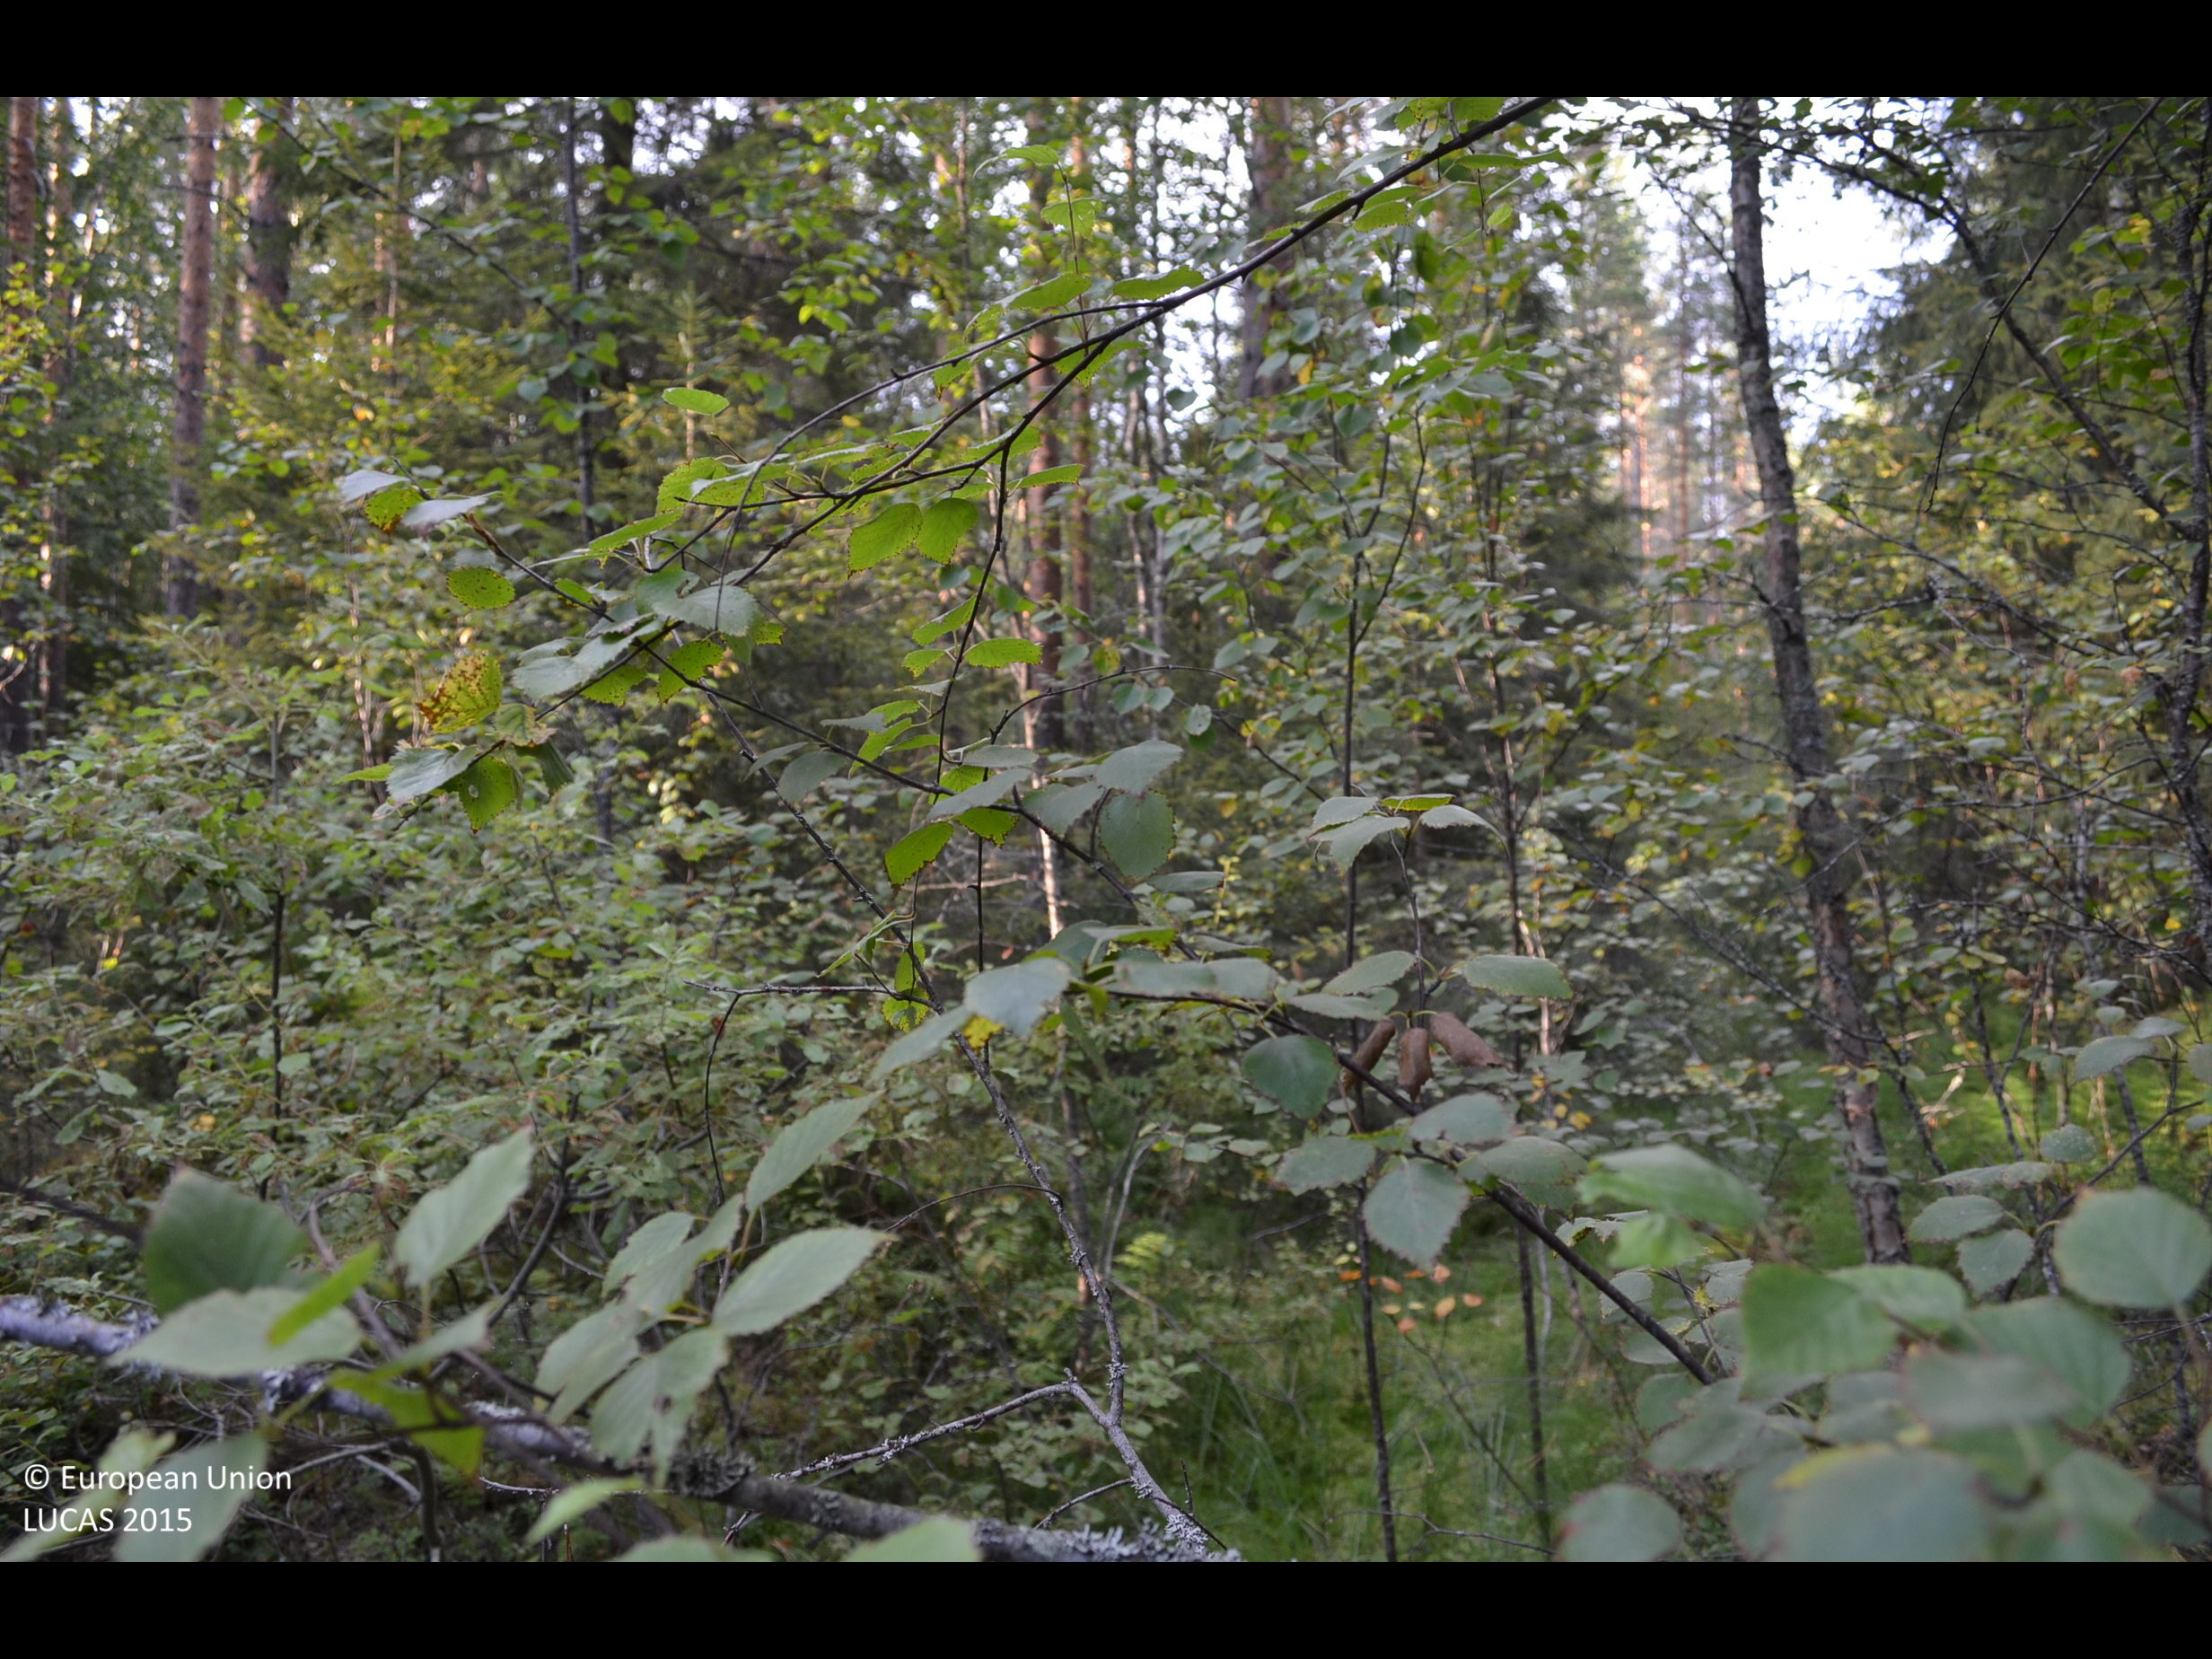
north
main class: Woodland
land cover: Pine dominated mixed woodland
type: boreal forest
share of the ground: > 75 %
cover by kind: coniferous forest trees 60 %, broadleaved forest trees 25 %, shrubs 10 %, herbaceous plants 5 %
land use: Forestry
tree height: > 5 m
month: August
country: FI
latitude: 62.4086
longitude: 24.4300
